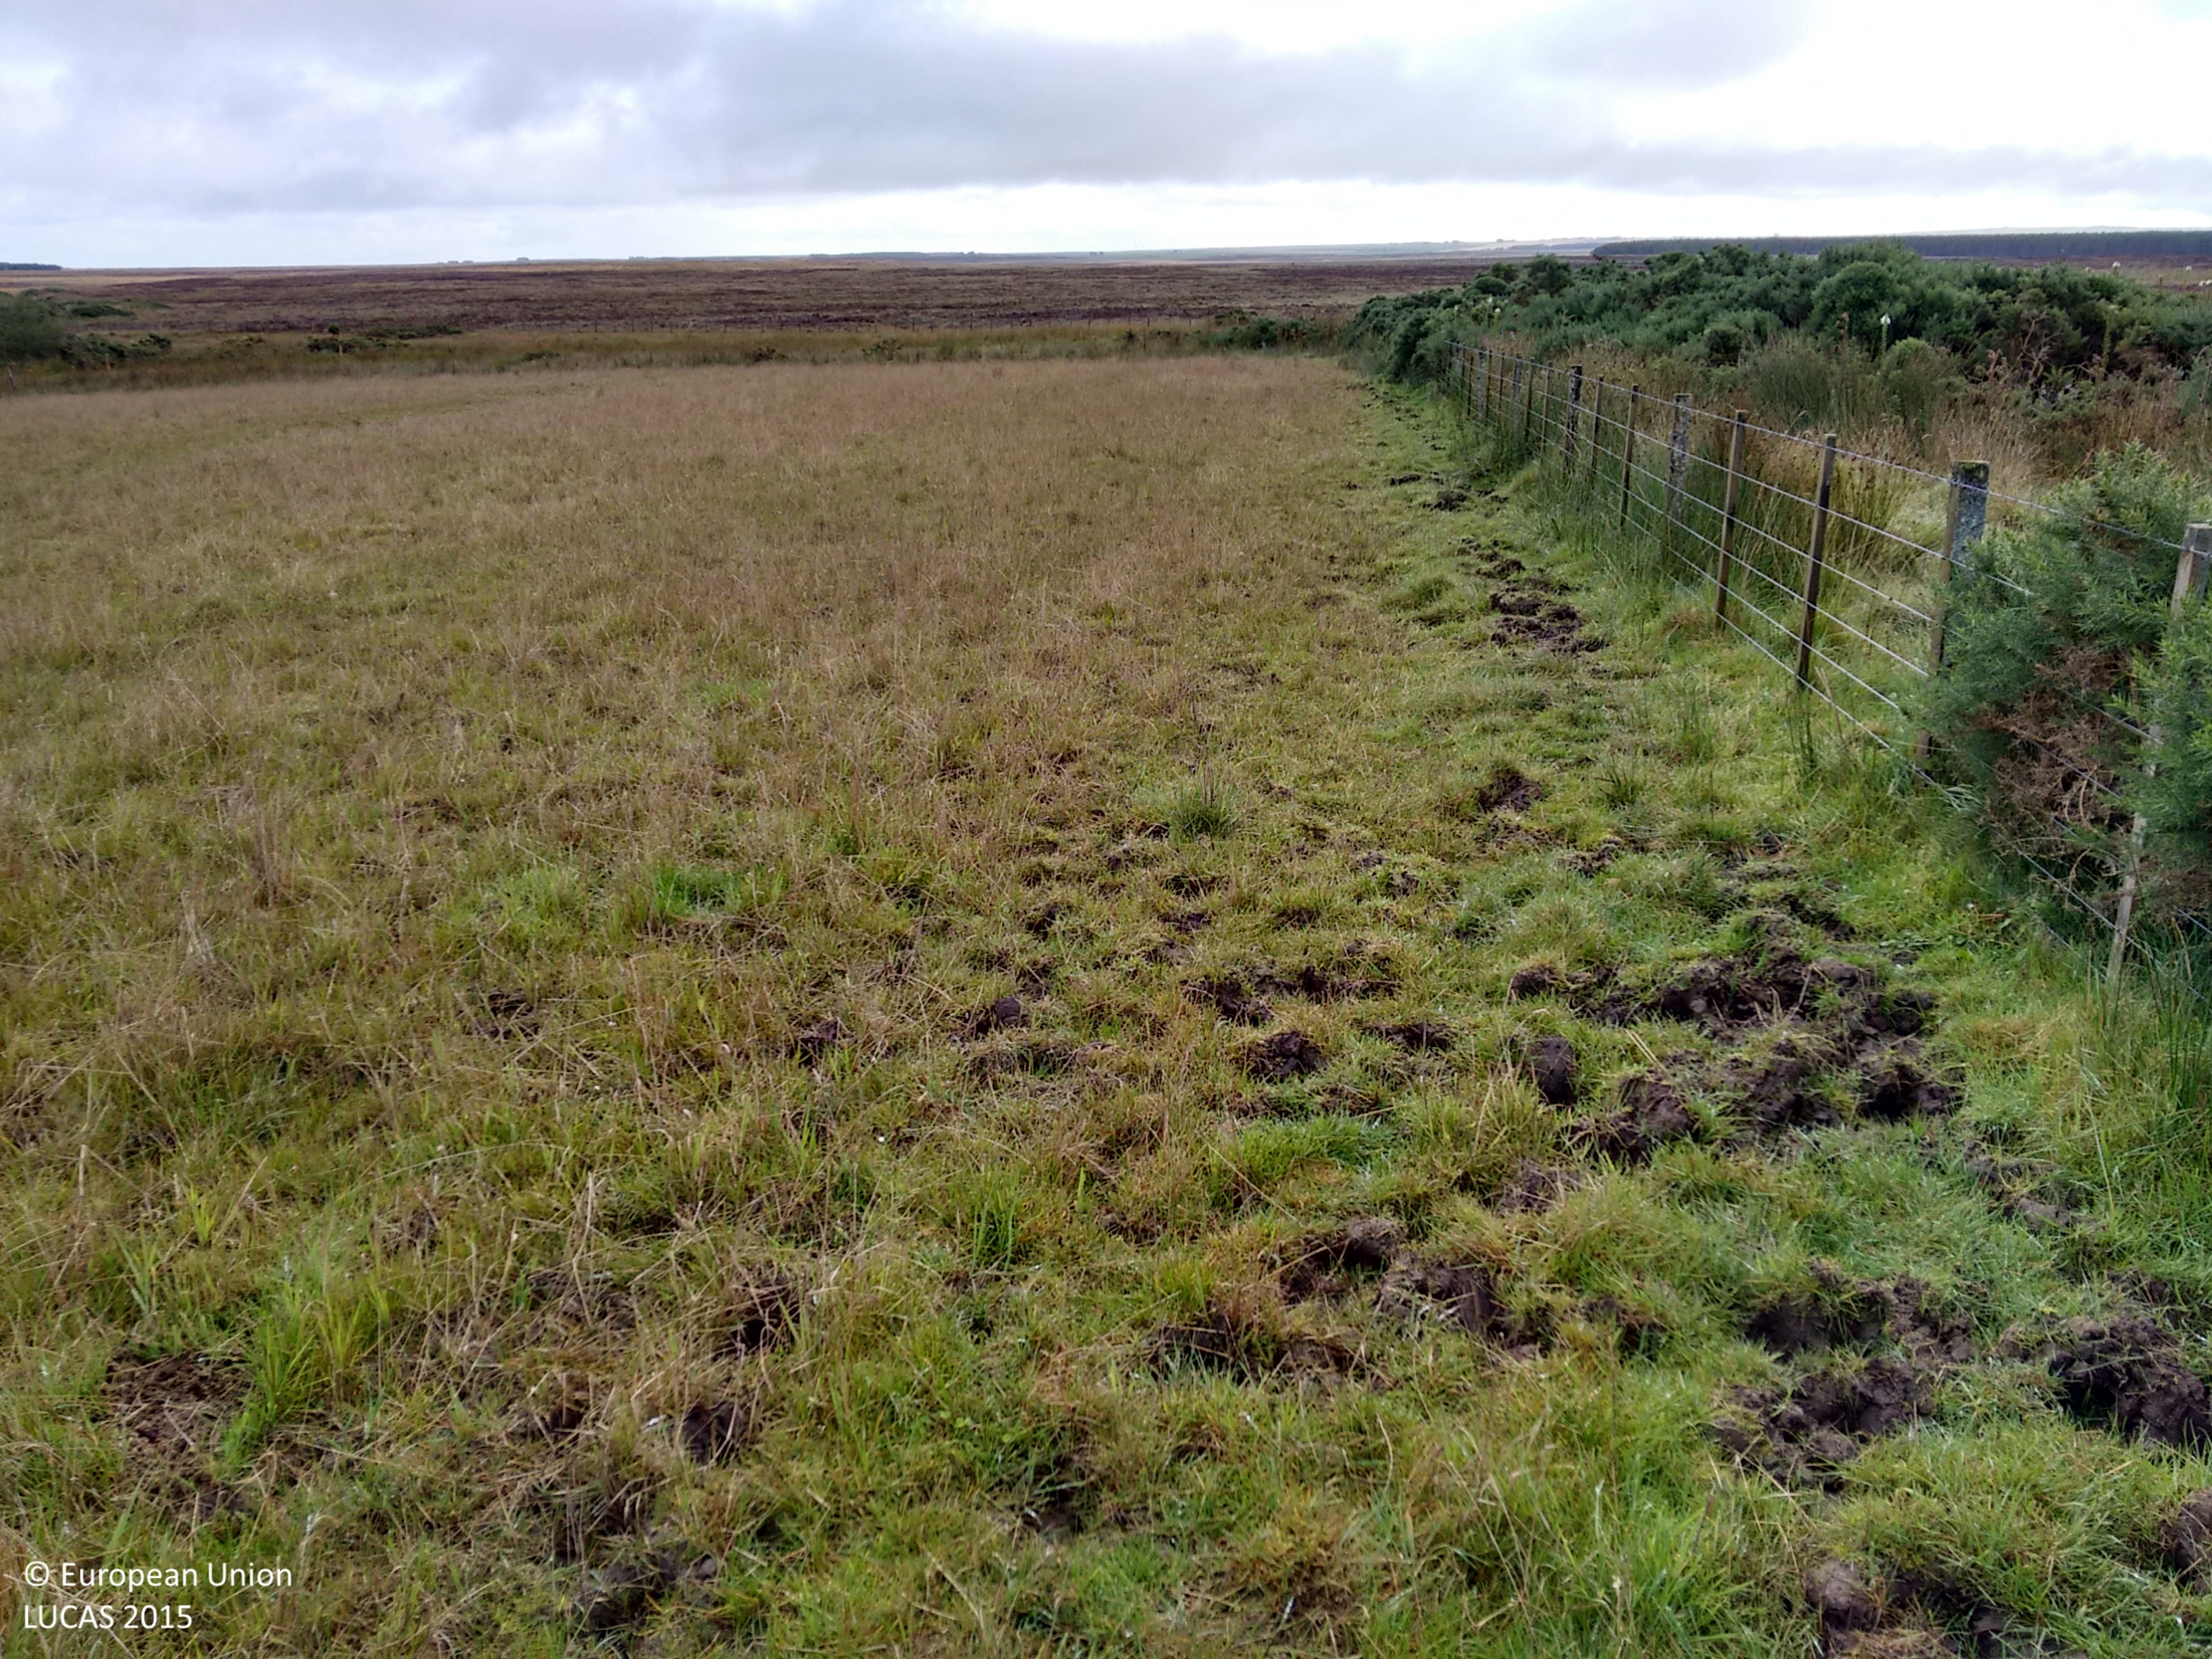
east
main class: Grassland
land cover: Grassland without tree/shrub cover
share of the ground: > 75 %
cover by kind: herbaceous plants 100 %
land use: Agriculture (excluding fallow land and kitchen gardens)
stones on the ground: < 10 %
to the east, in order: Grassland without tree/shrub cover; Fences; Peatbogs; Fences; Shrubland without tree cover; Peatbogs
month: August
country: GB
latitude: 58.4912
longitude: -3.2522
